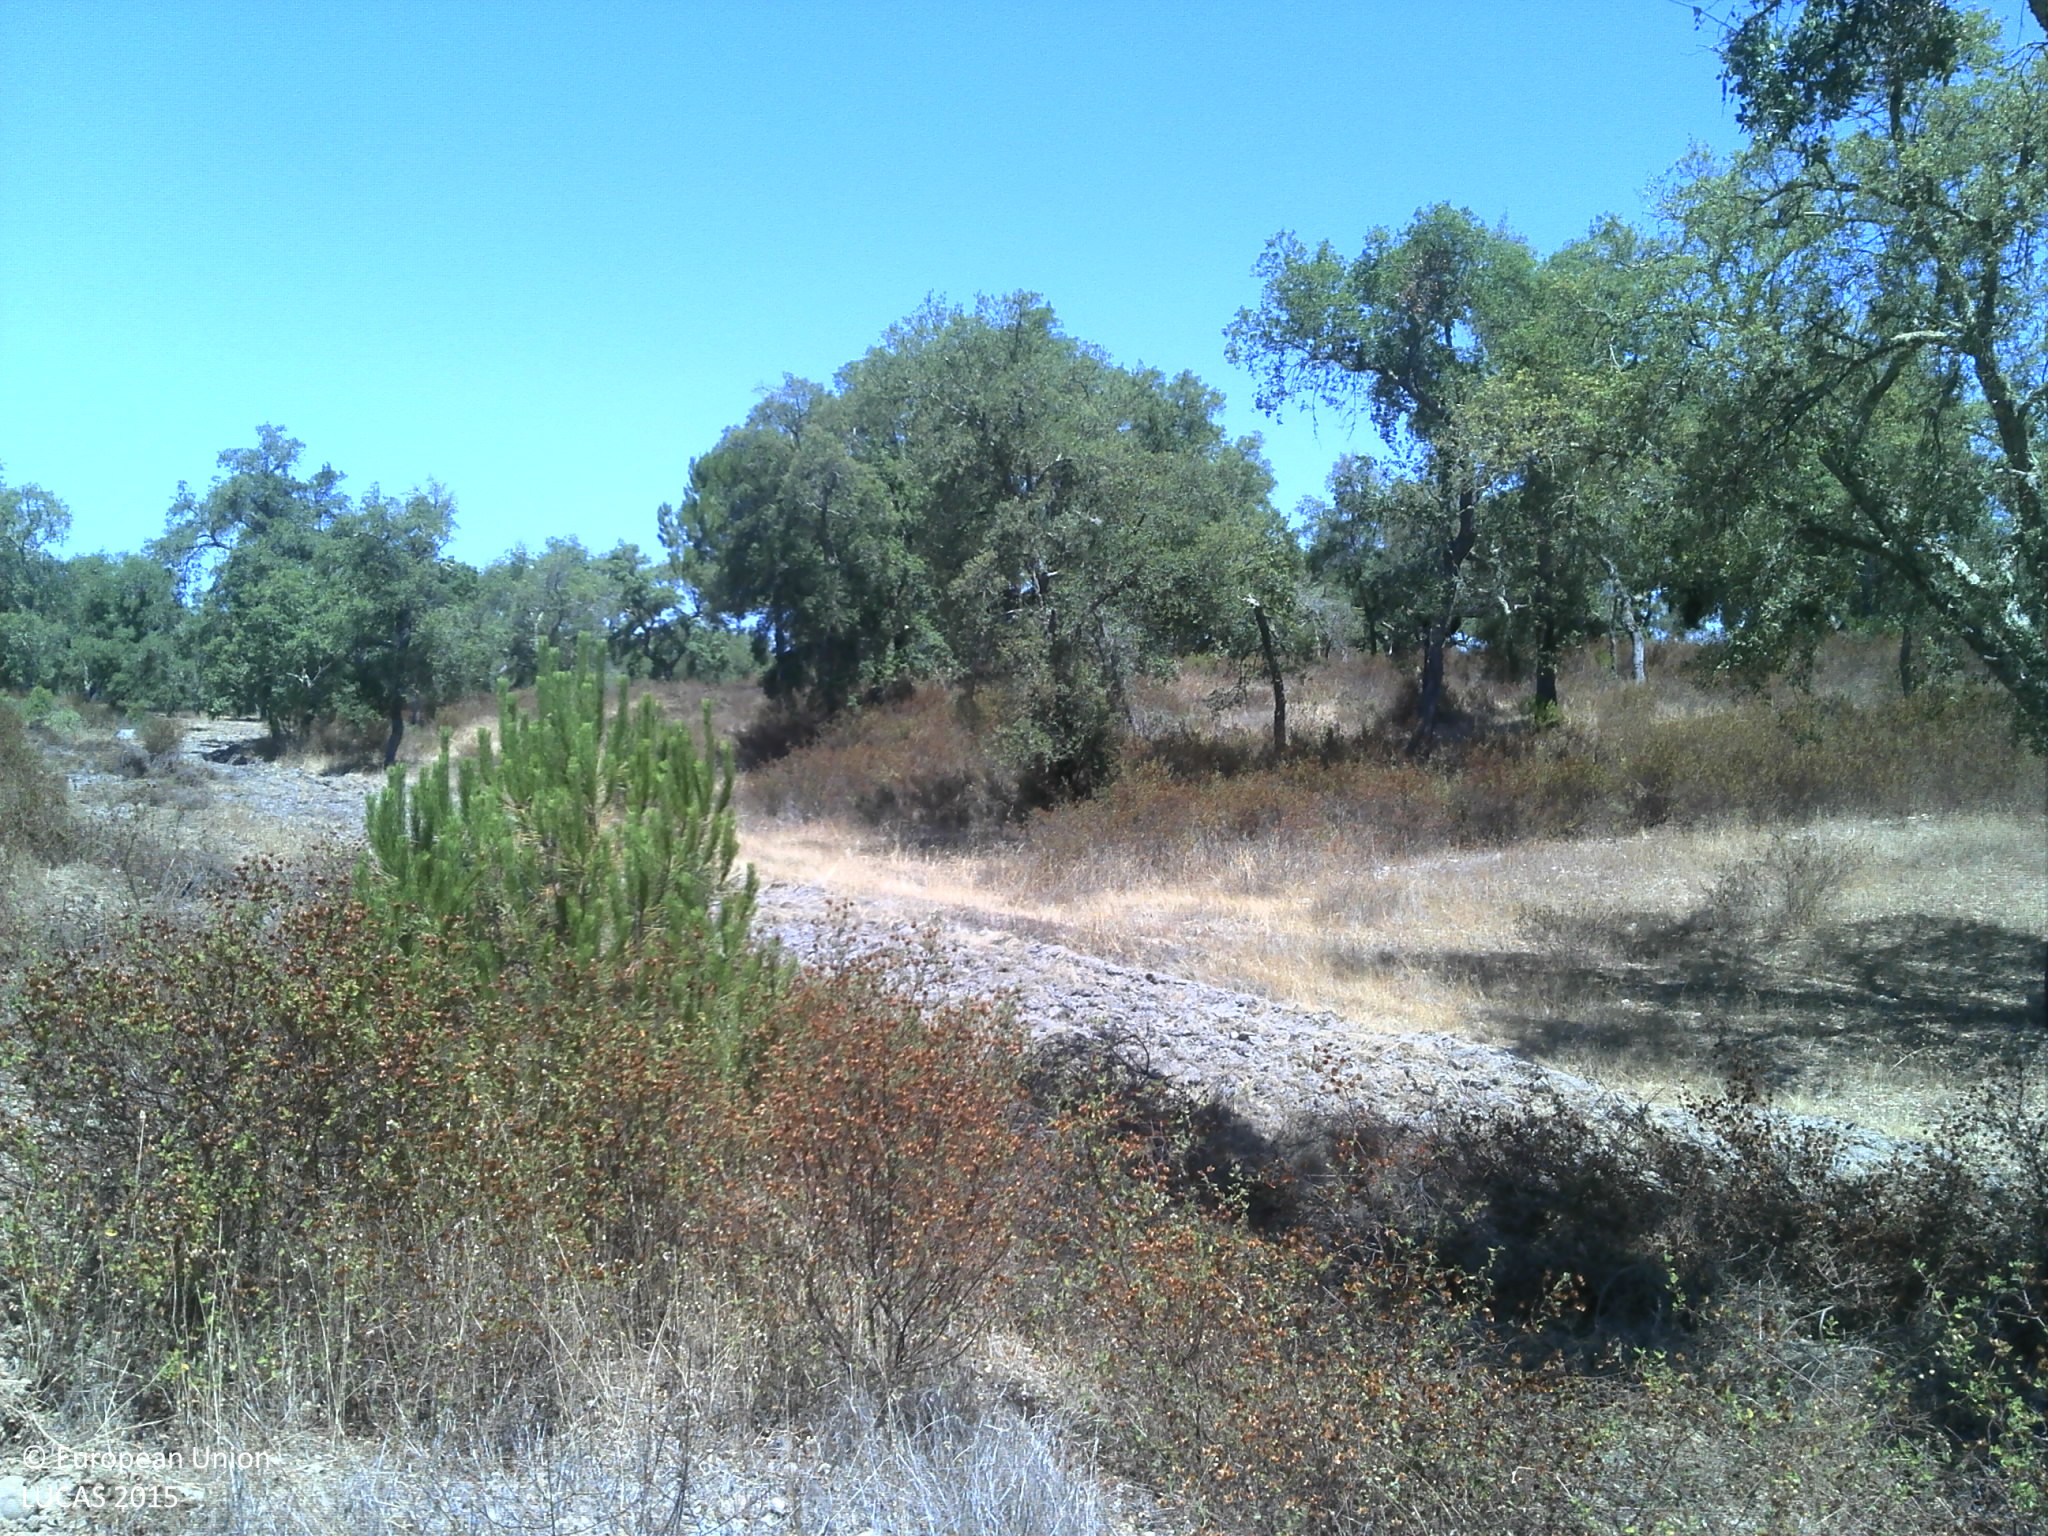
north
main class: Woodland
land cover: Broadleaved woodland
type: broadleaved evergreen forest
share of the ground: 25 - 50 %
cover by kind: unconsolidated bare surface 40 %, broadleaved forest trees 35 %, shrubs 15 %, herbaceous plants 10 %
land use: Forestry
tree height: > 5 m
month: July
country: PT
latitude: 39.0293
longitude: -8.2979
